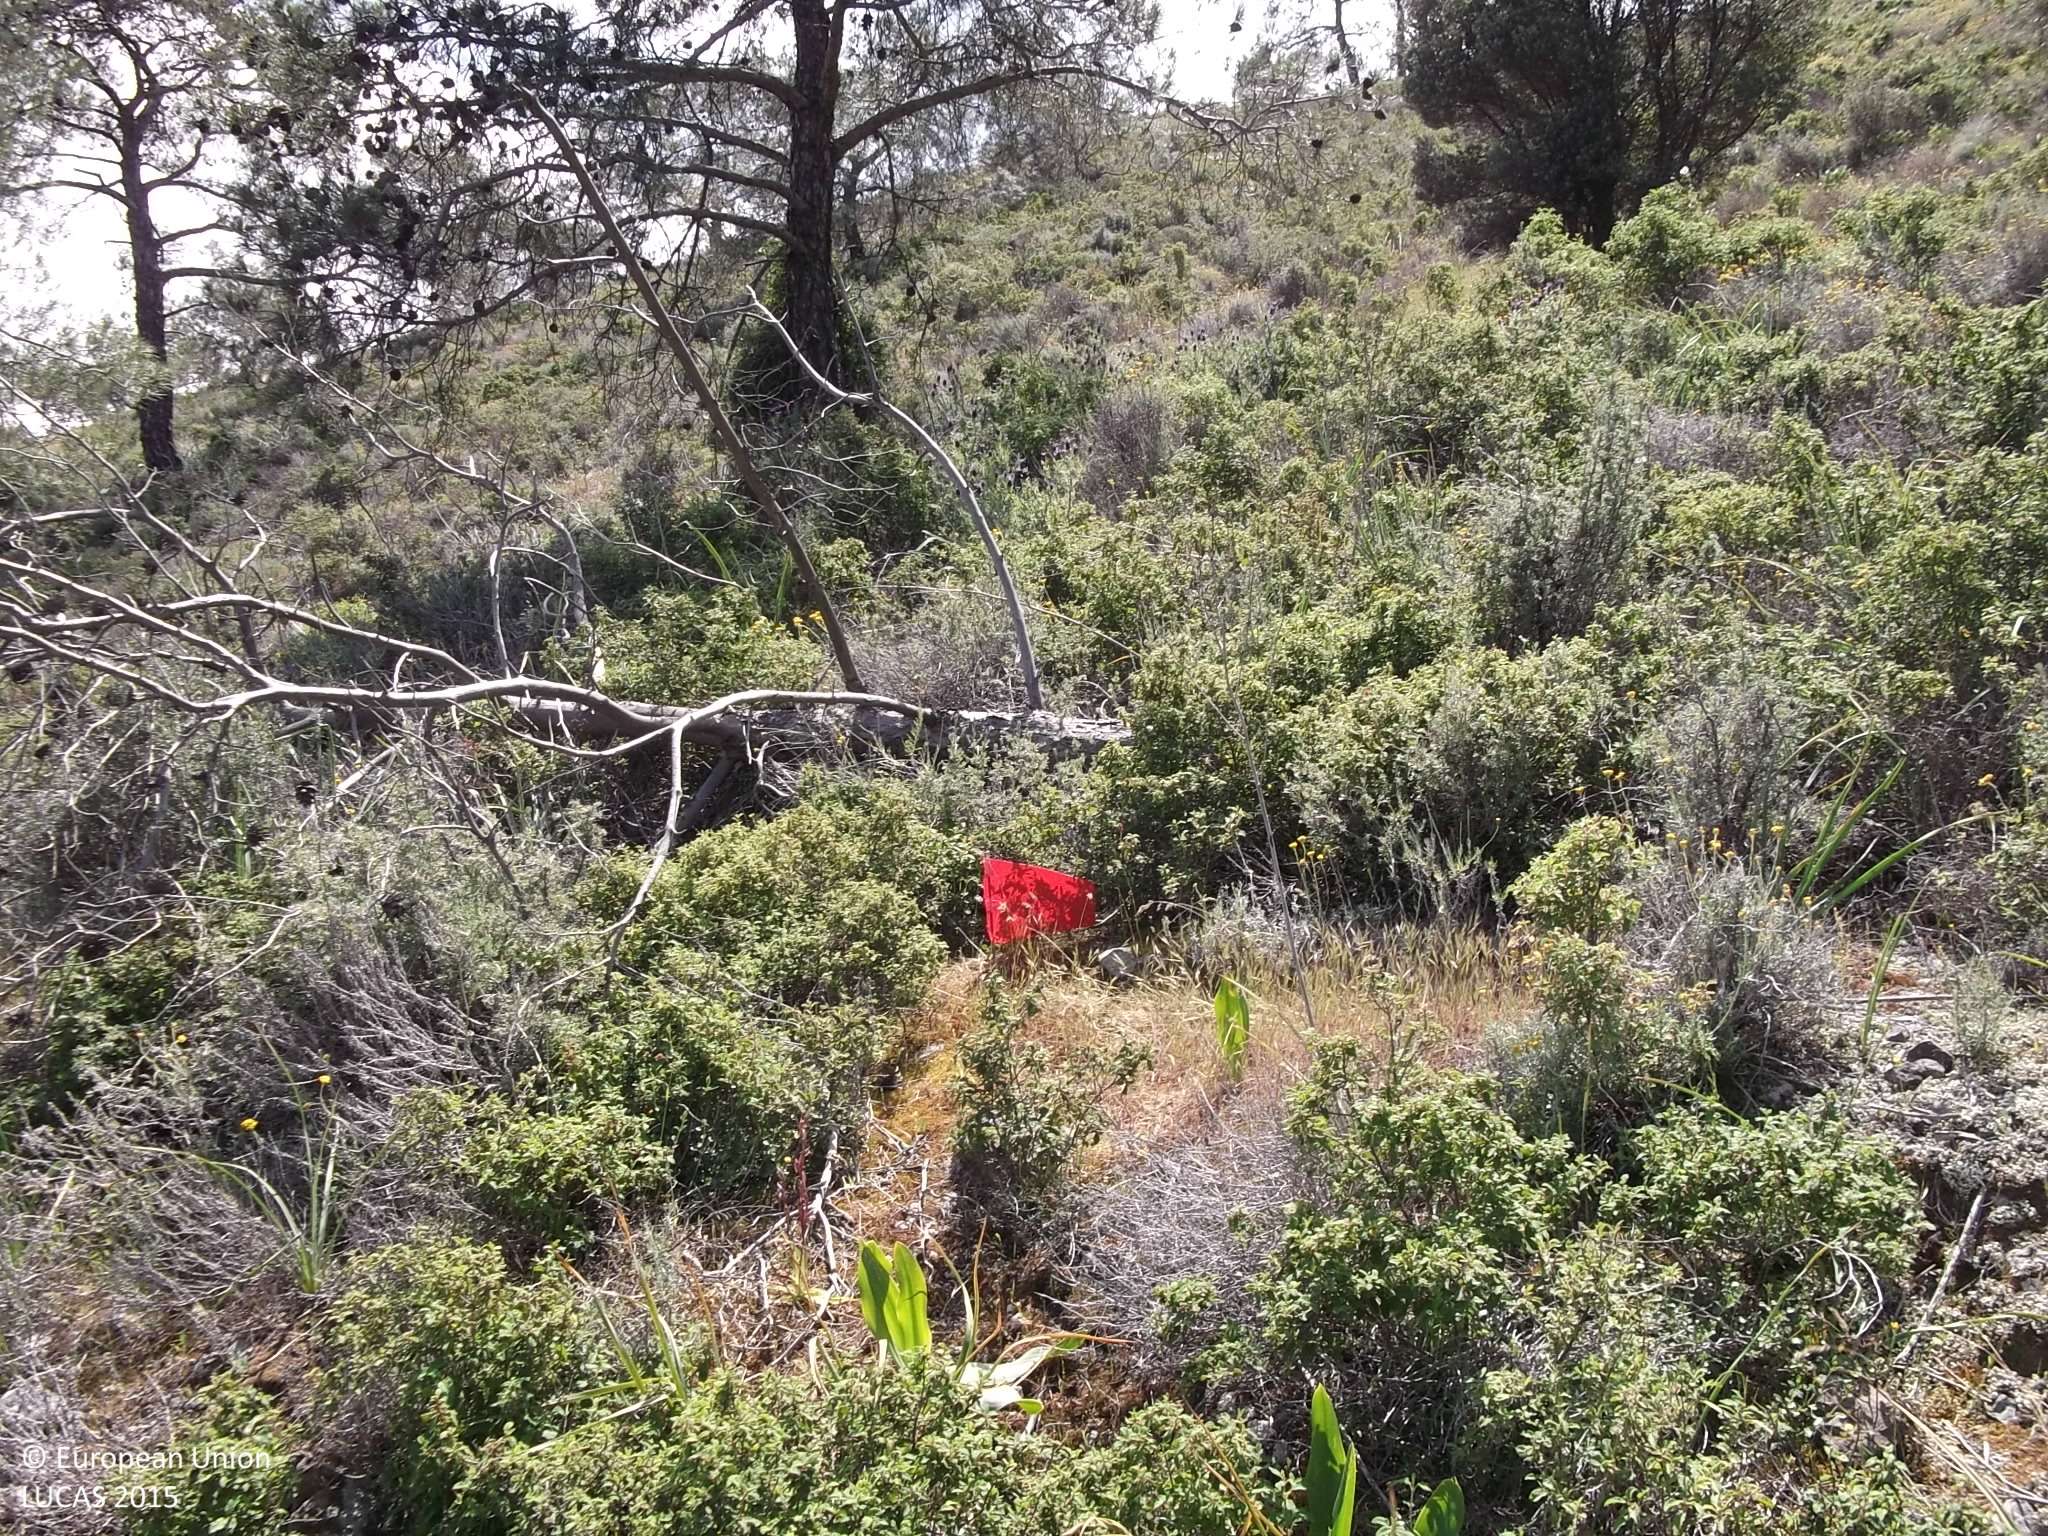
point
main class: Woodland
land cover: Pine dominated coniferous woodland
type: coniferous forest of the mediterranean region
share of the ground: > 75 %
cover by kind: coniferous forest trees 70 %, shrubs 25 %, broadleaved forest trees 5 %
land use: Semi-natural and natural areas not in use
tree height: > 5 m
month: April
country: CY
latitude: 34.8698
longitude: 33.4331
